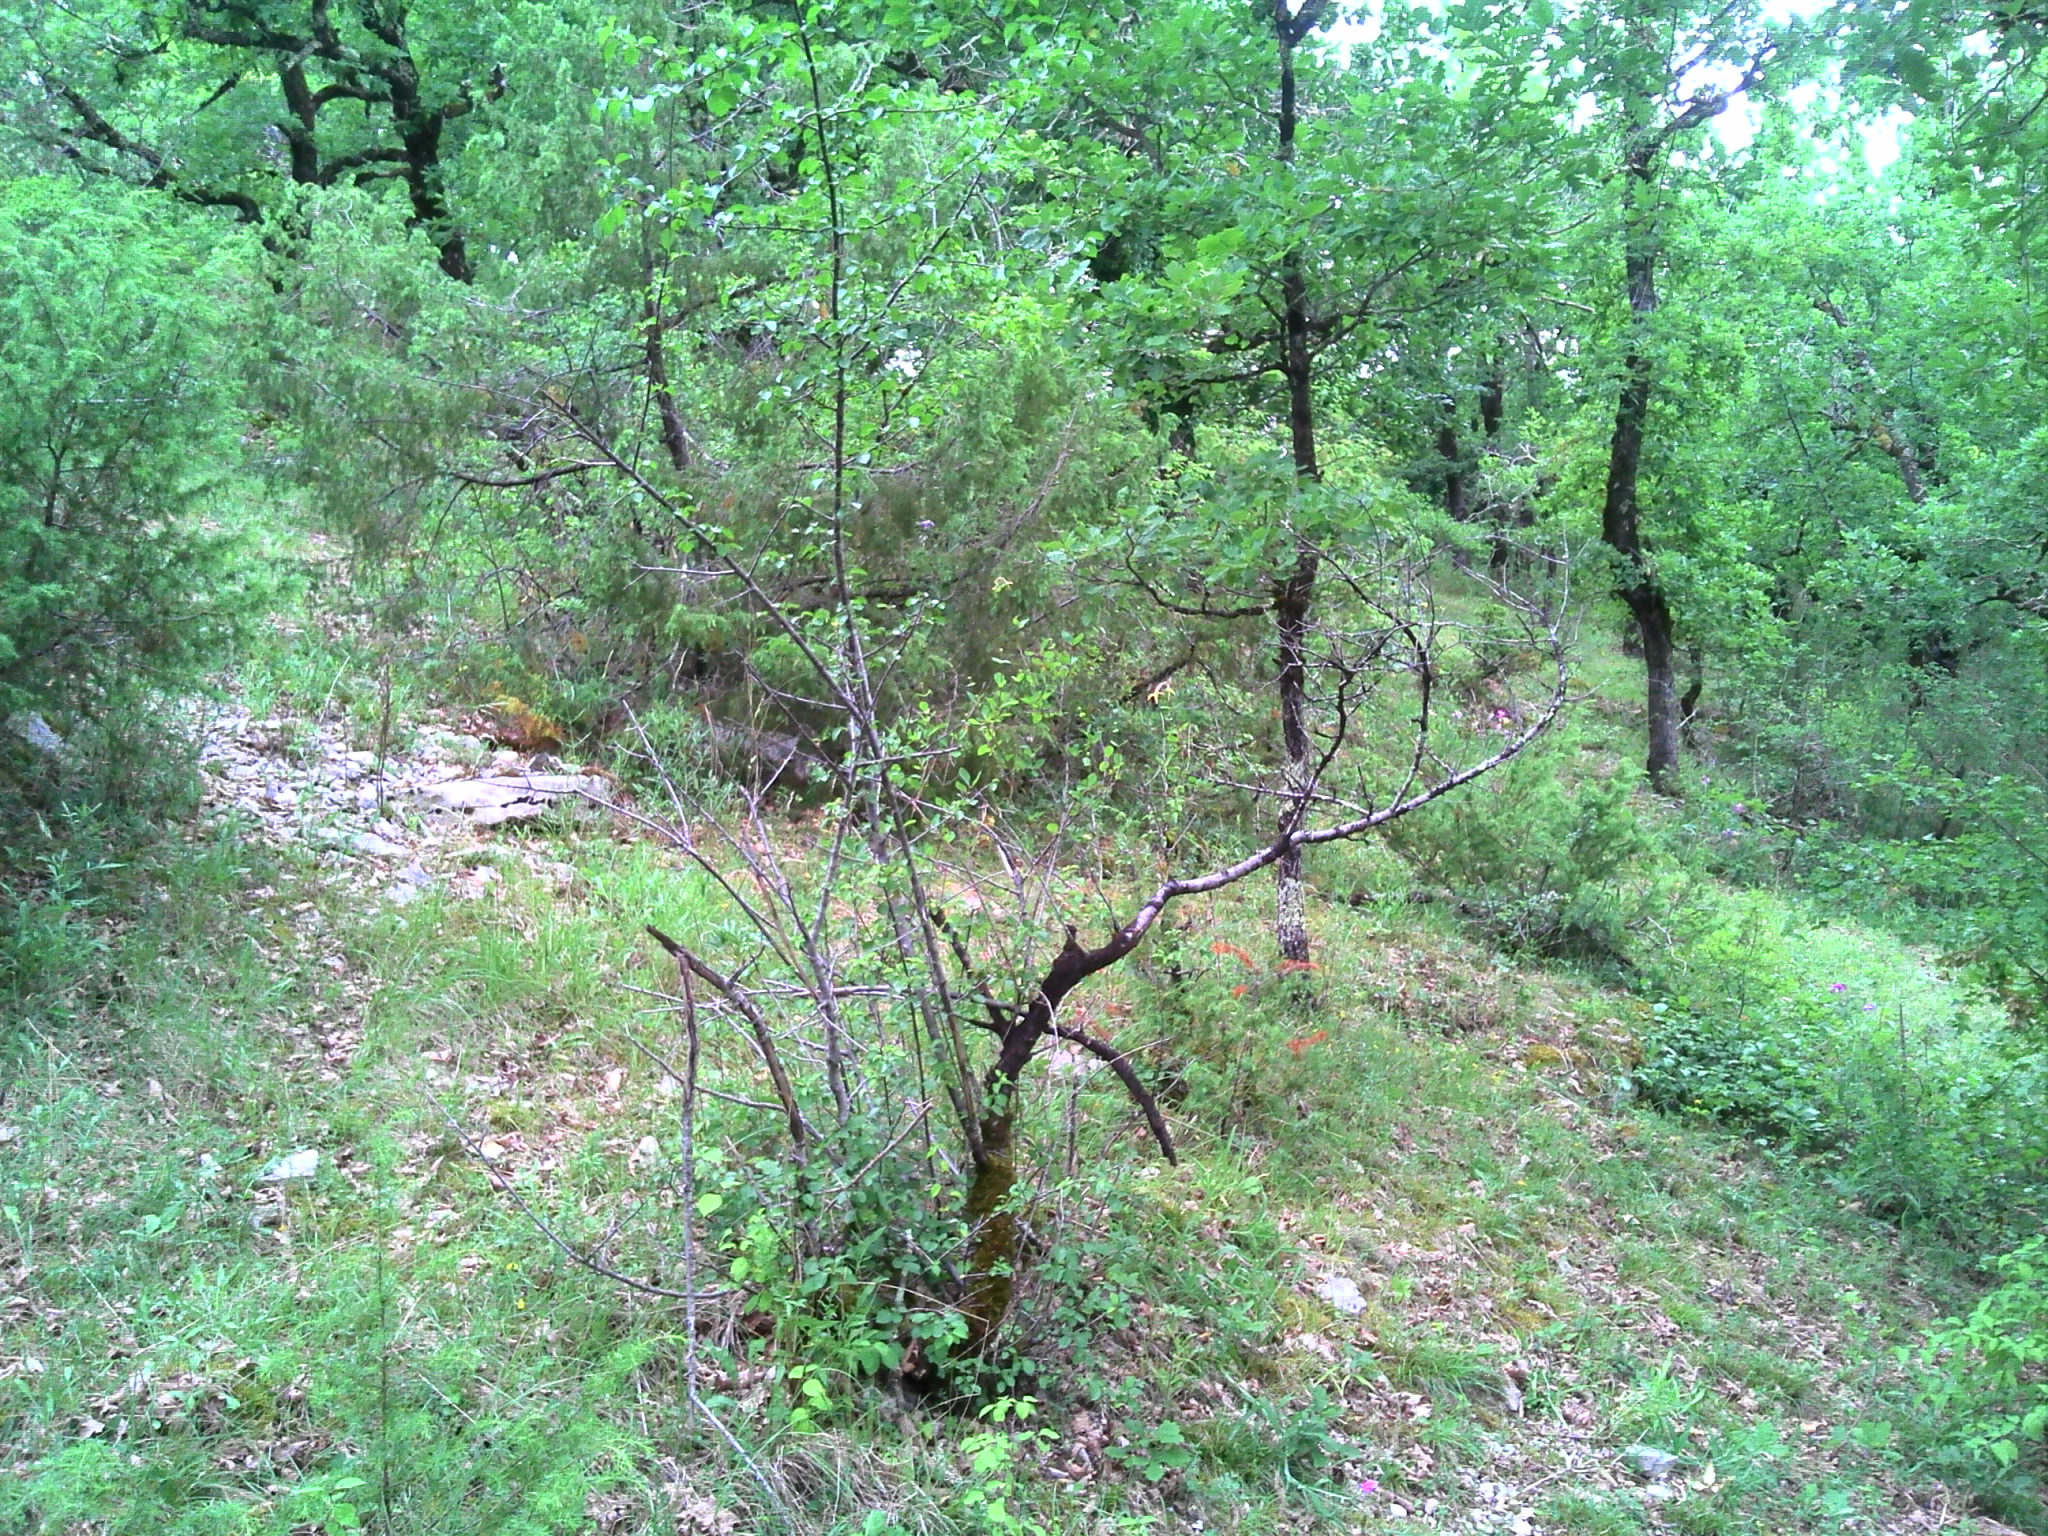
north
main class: Woodland
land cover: Broadleaved woodland
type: thermophilous deciduous forest
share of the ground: 50 - 75 %
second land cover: Grassland without tree/shrub cover
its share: 25 - 50 %
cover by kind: broadleaved forest trees 80 %, herbaceous plants 20 %
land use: Forestry
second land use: Agriculture (excluding fallow land and kitchen gardens)
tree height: > 5 m
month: June
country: FR
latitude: 44.4280
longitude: 1.8478
